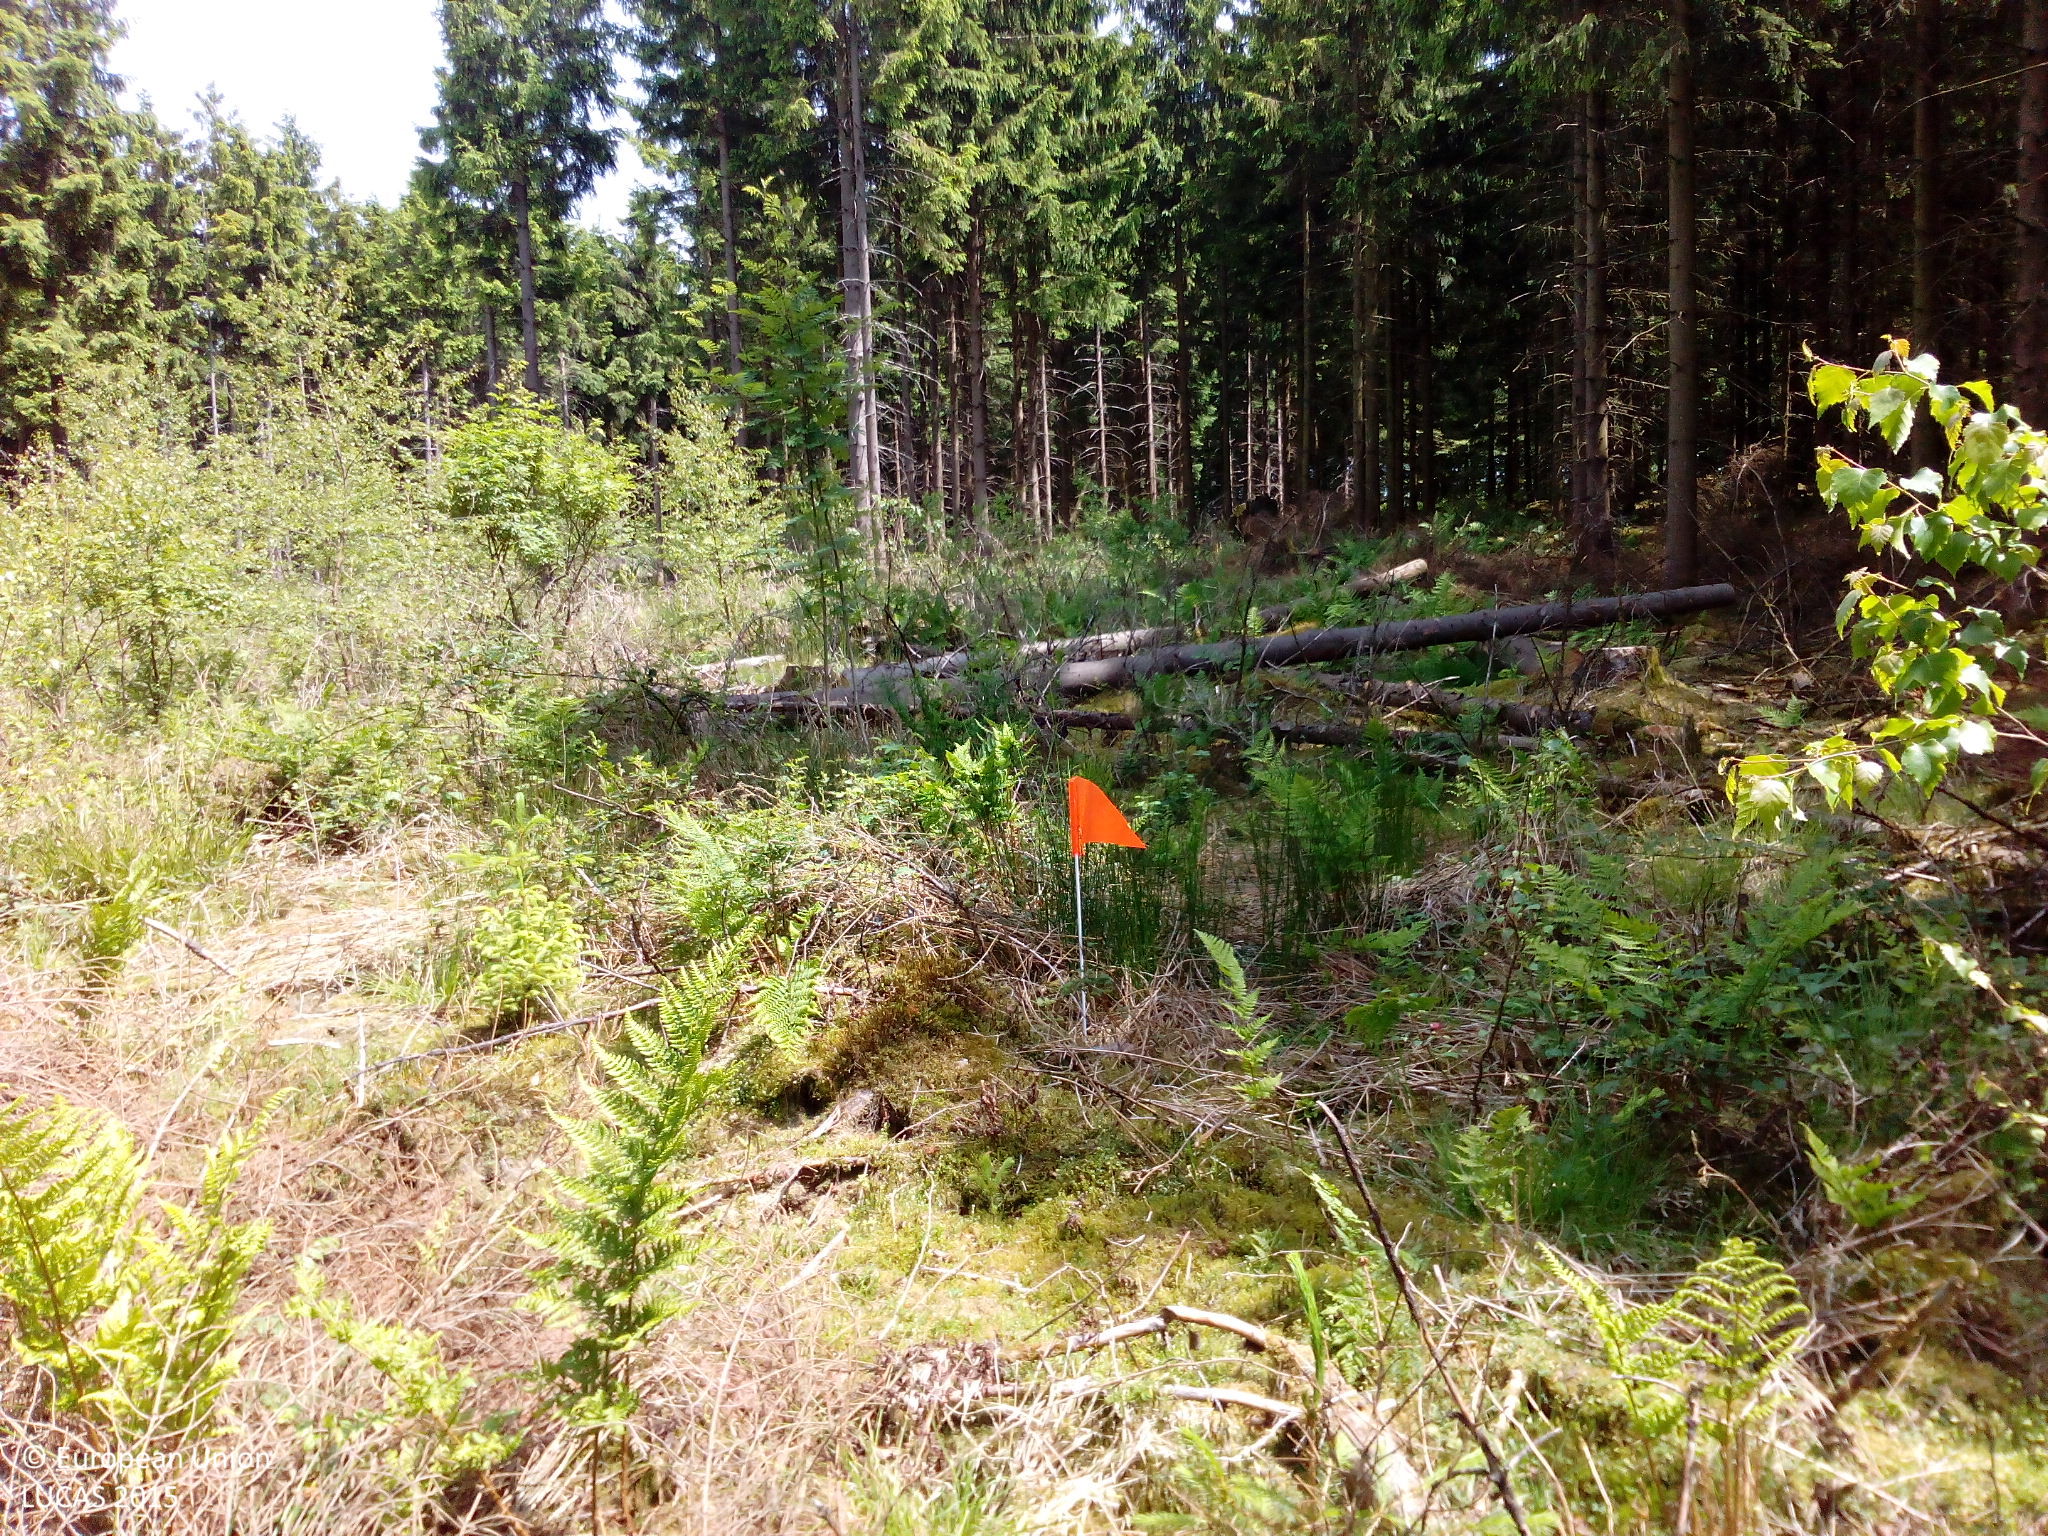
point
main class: Woodland
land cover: Spruce dominated mixed woodland
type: hemiboreal forest and nemoral coniferous forest and mixed broadleaved-coniferous forest
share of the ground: 50 - 75 %
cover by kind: coniferous forest trees 40 %, broadleaved forest trees 25 %, herbaceous plants 20 %, shrubs 15 %
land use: Forestry
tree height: > 5 m
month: June
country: DE
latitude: 51.3967
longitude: 8.4625
